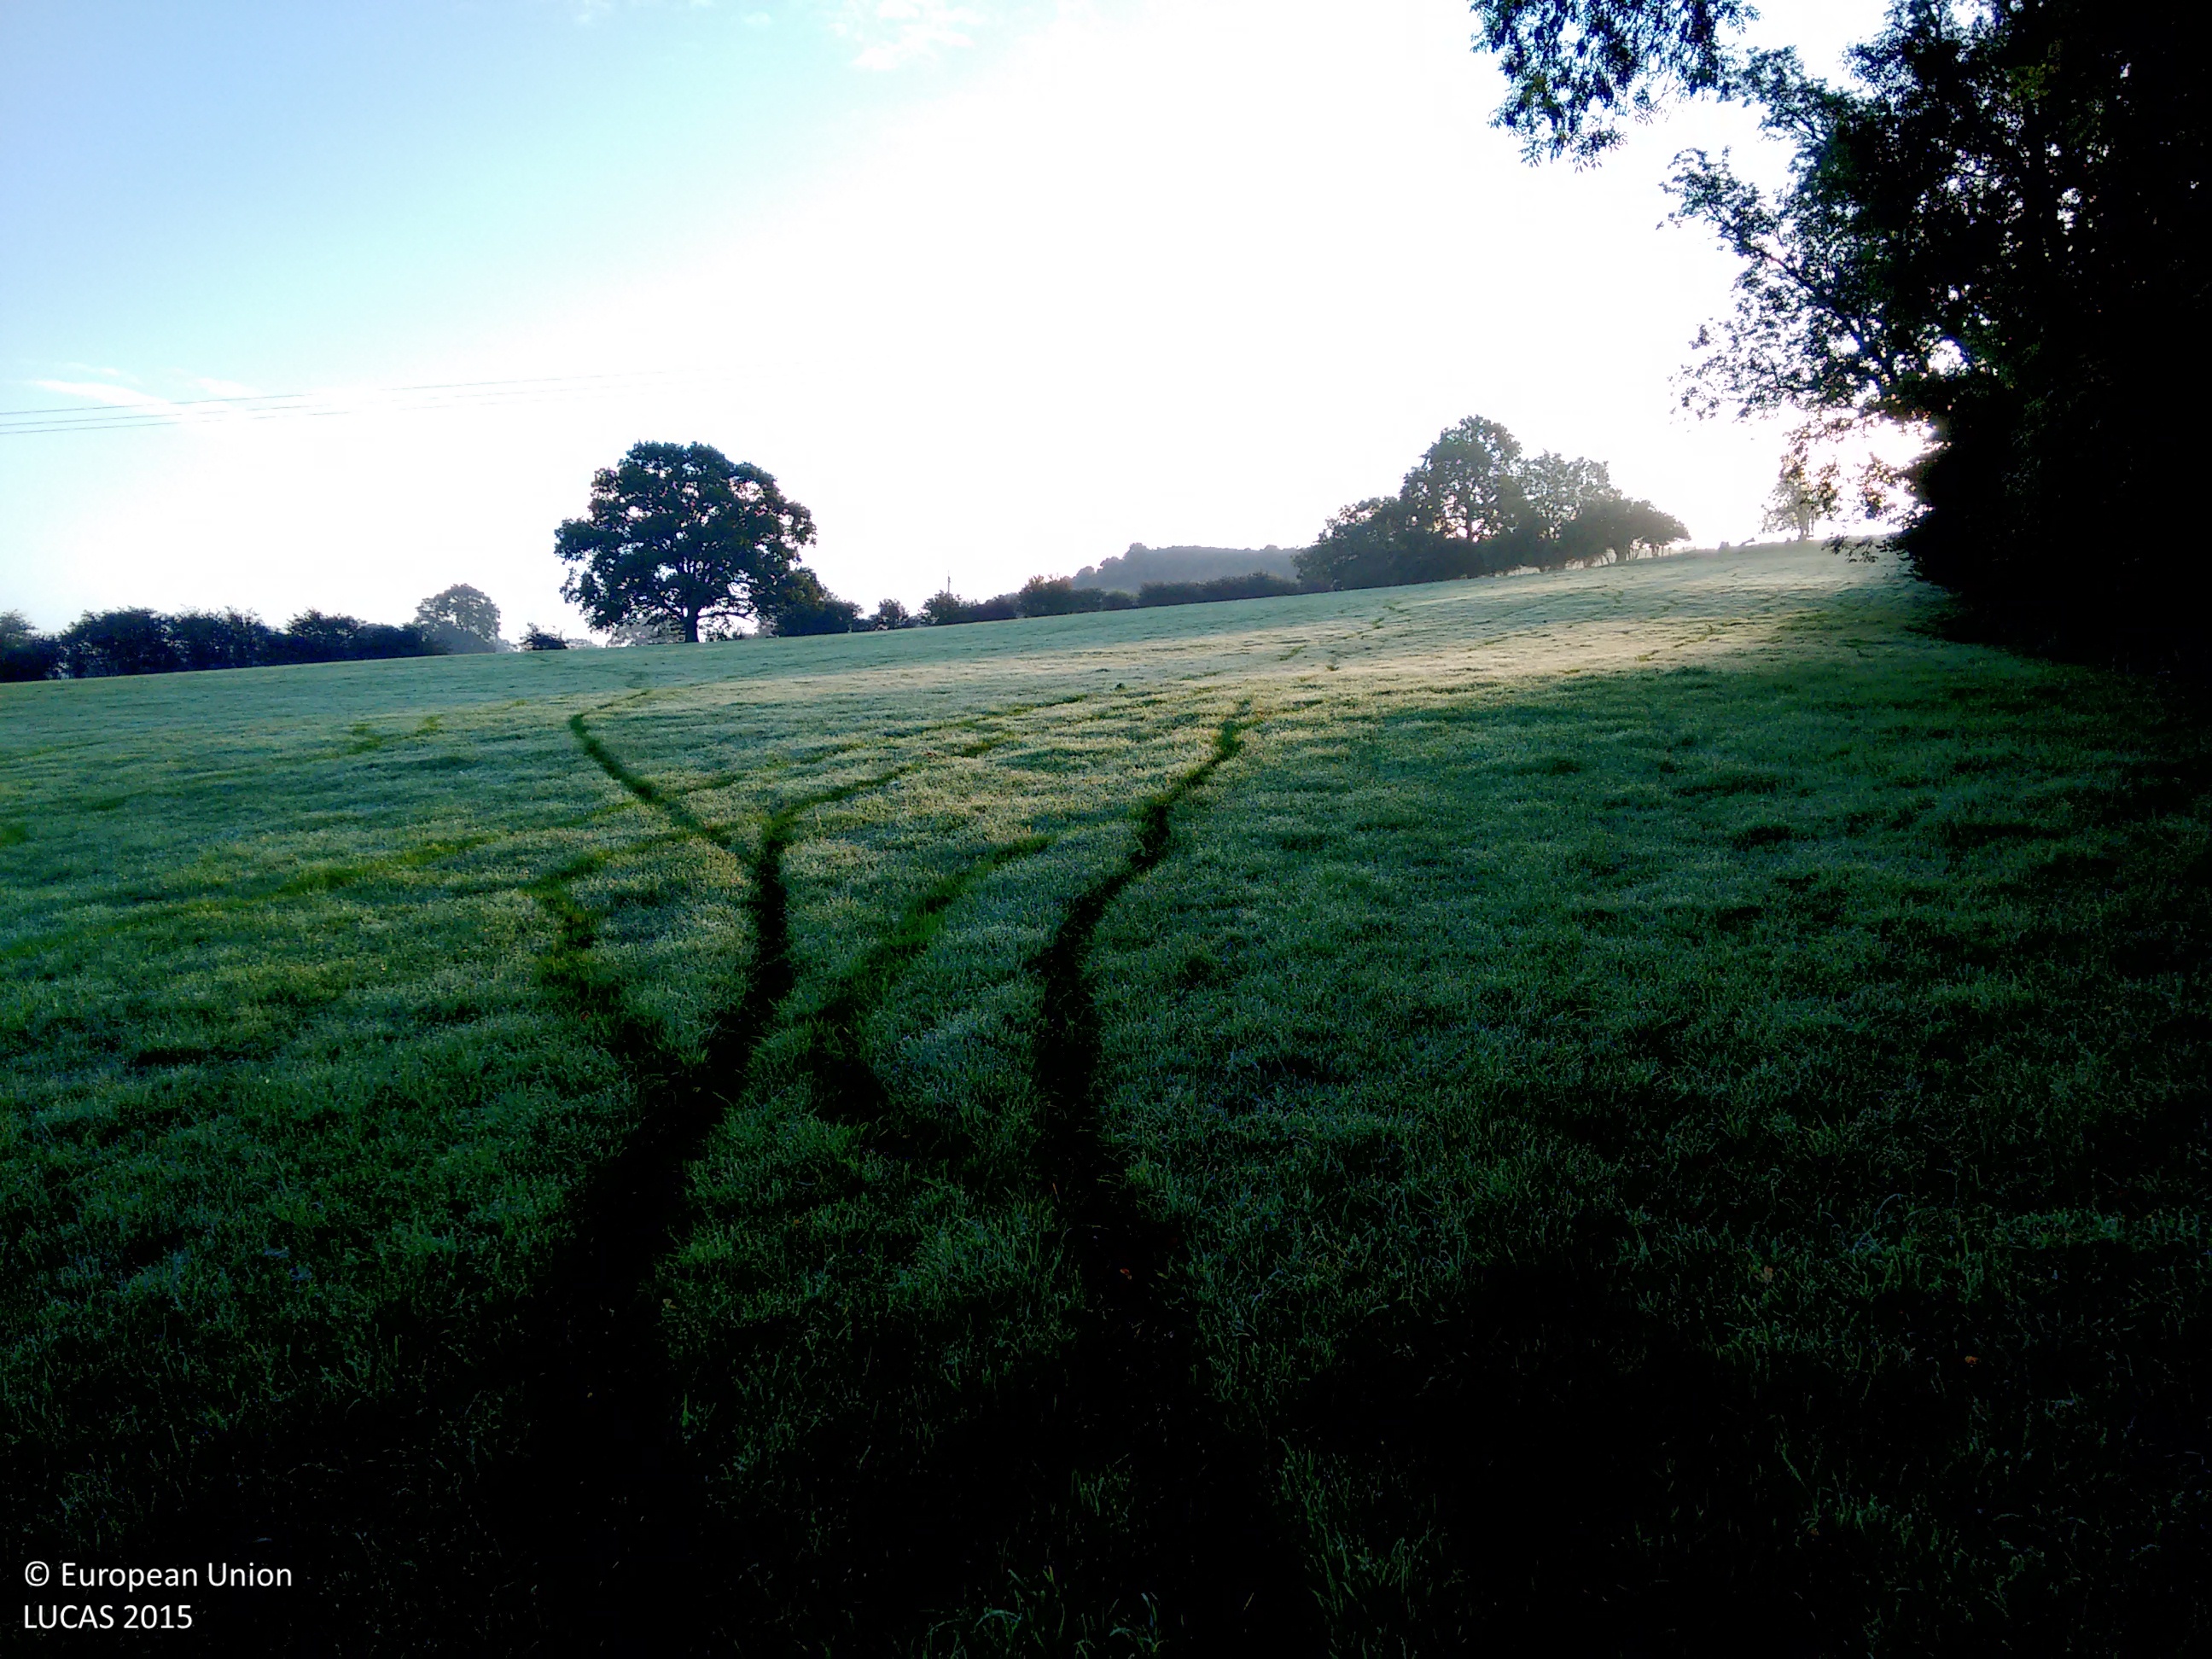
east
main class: Grassland
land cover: Grassland without tree/shrub cover
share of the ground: > 75 %
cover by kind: herbaceous plants 100 %
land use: Agriculture (excluding fallow land and kitchen gardens)
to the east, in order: Grassland without tree/shrub cover; Fences; Managed hedges; Grassland without tree/shrub cover
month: October
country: GB
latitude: 51.6935
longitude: -2.3464
